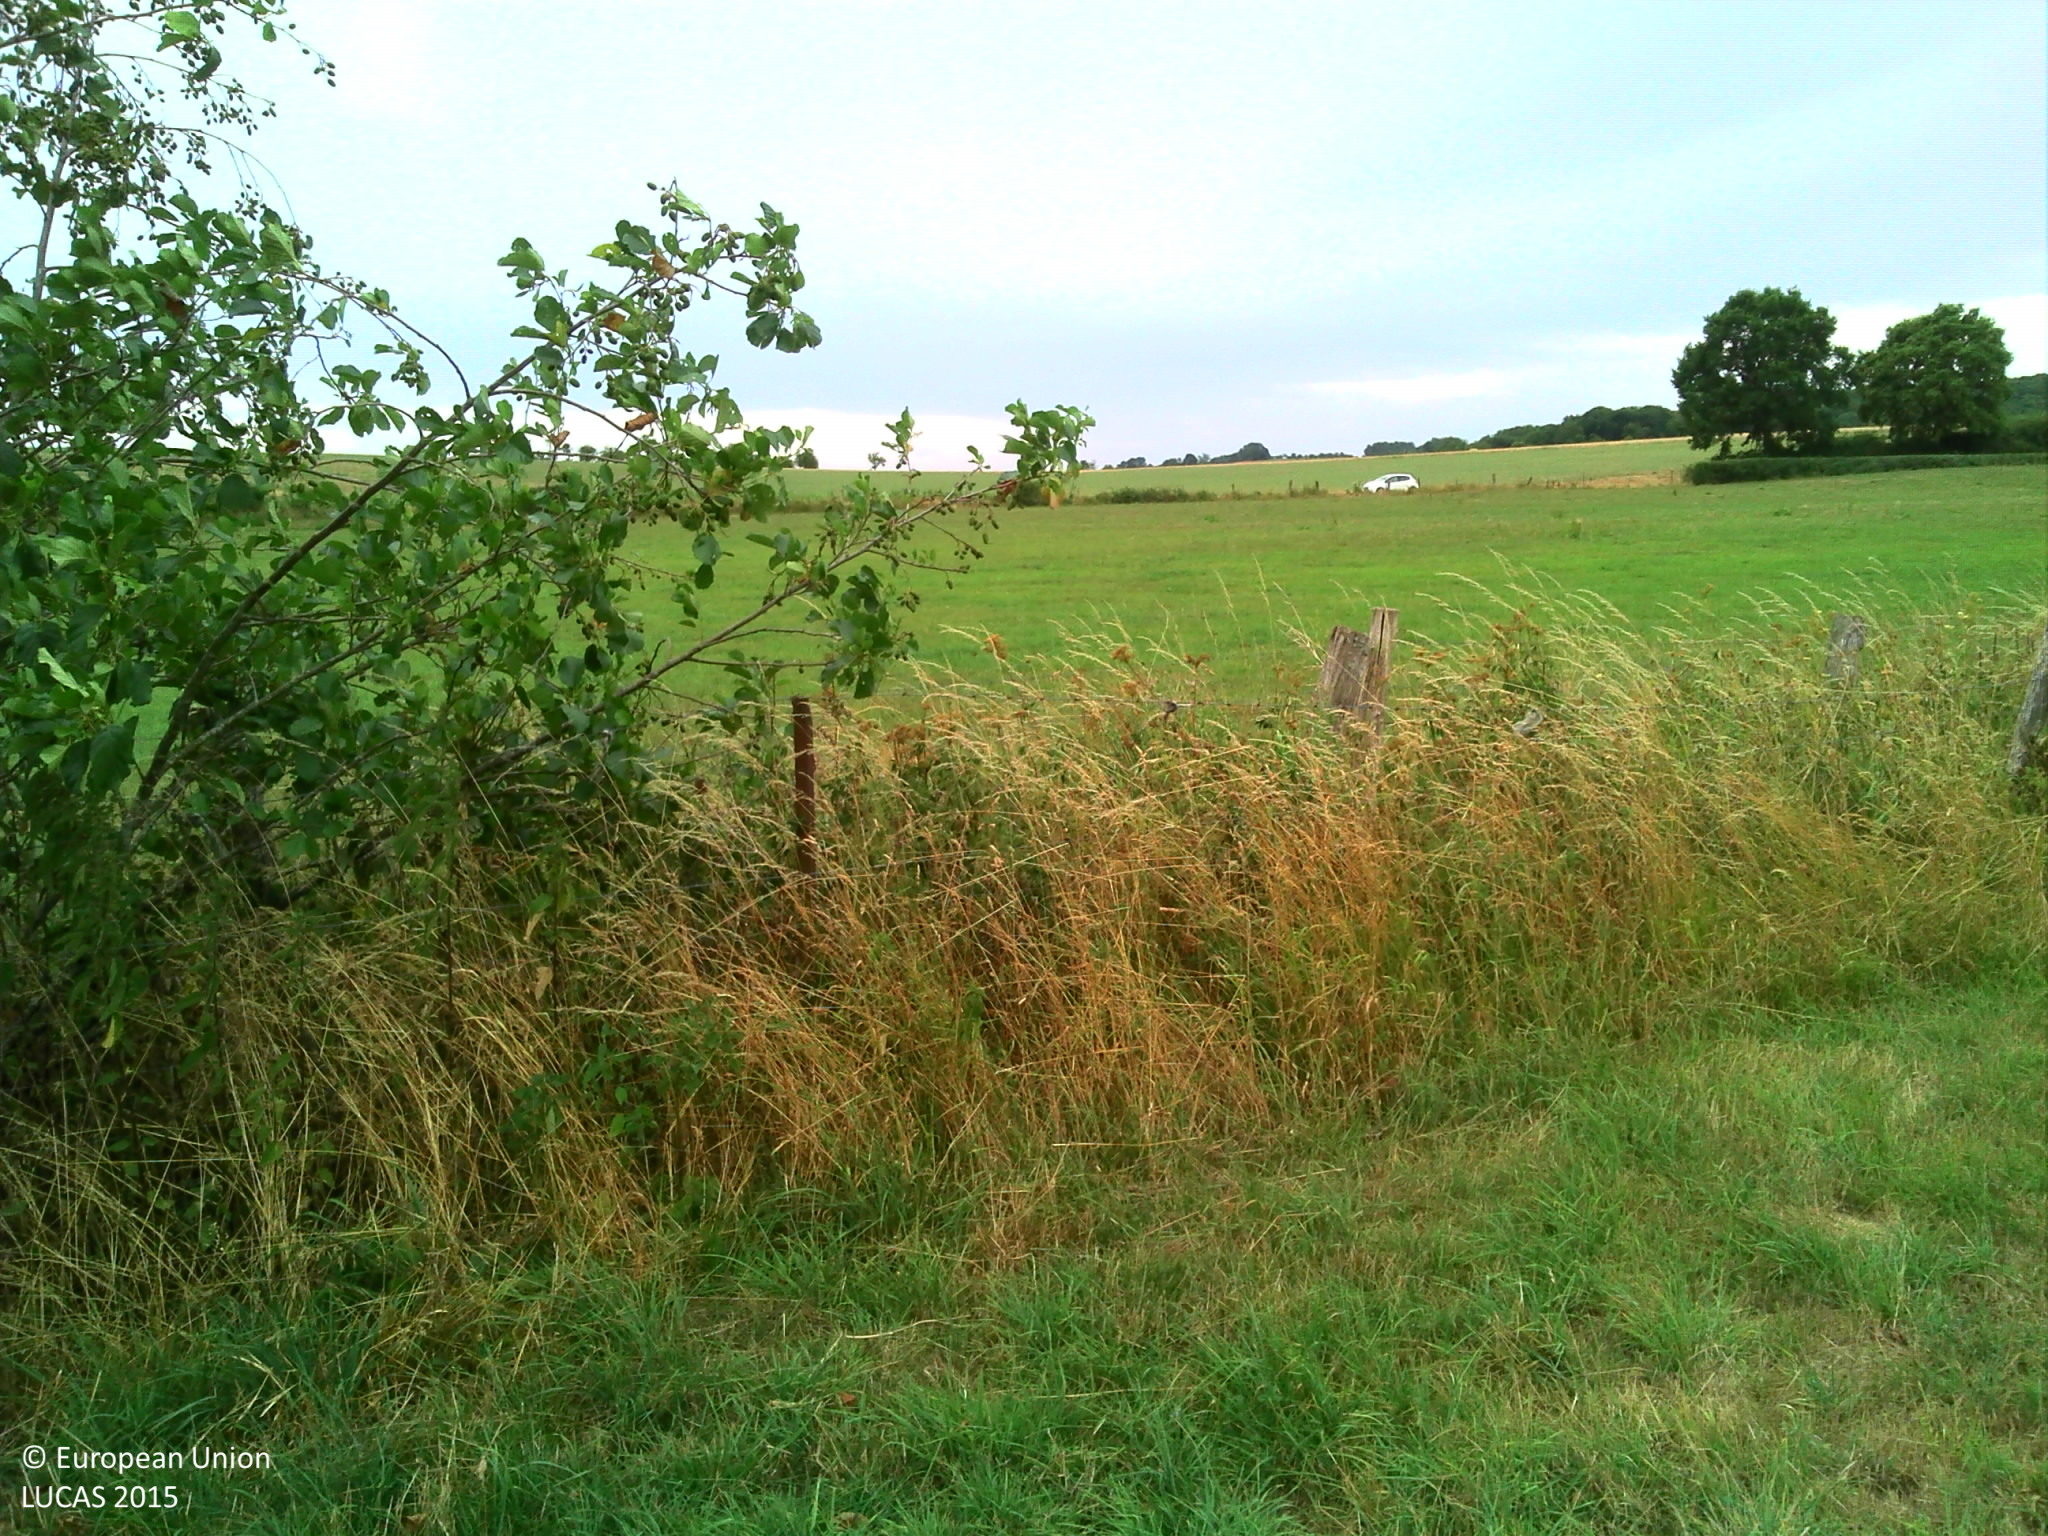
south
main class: Grassland
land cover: Grassland without tree/shrub cover
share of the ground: > 75 %
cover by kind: herbaceous plants 100 %
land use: Agriculture (excluding fallow land and kitchen gardens)
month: July
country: FR
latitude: 48.3688
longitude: 6.0450
